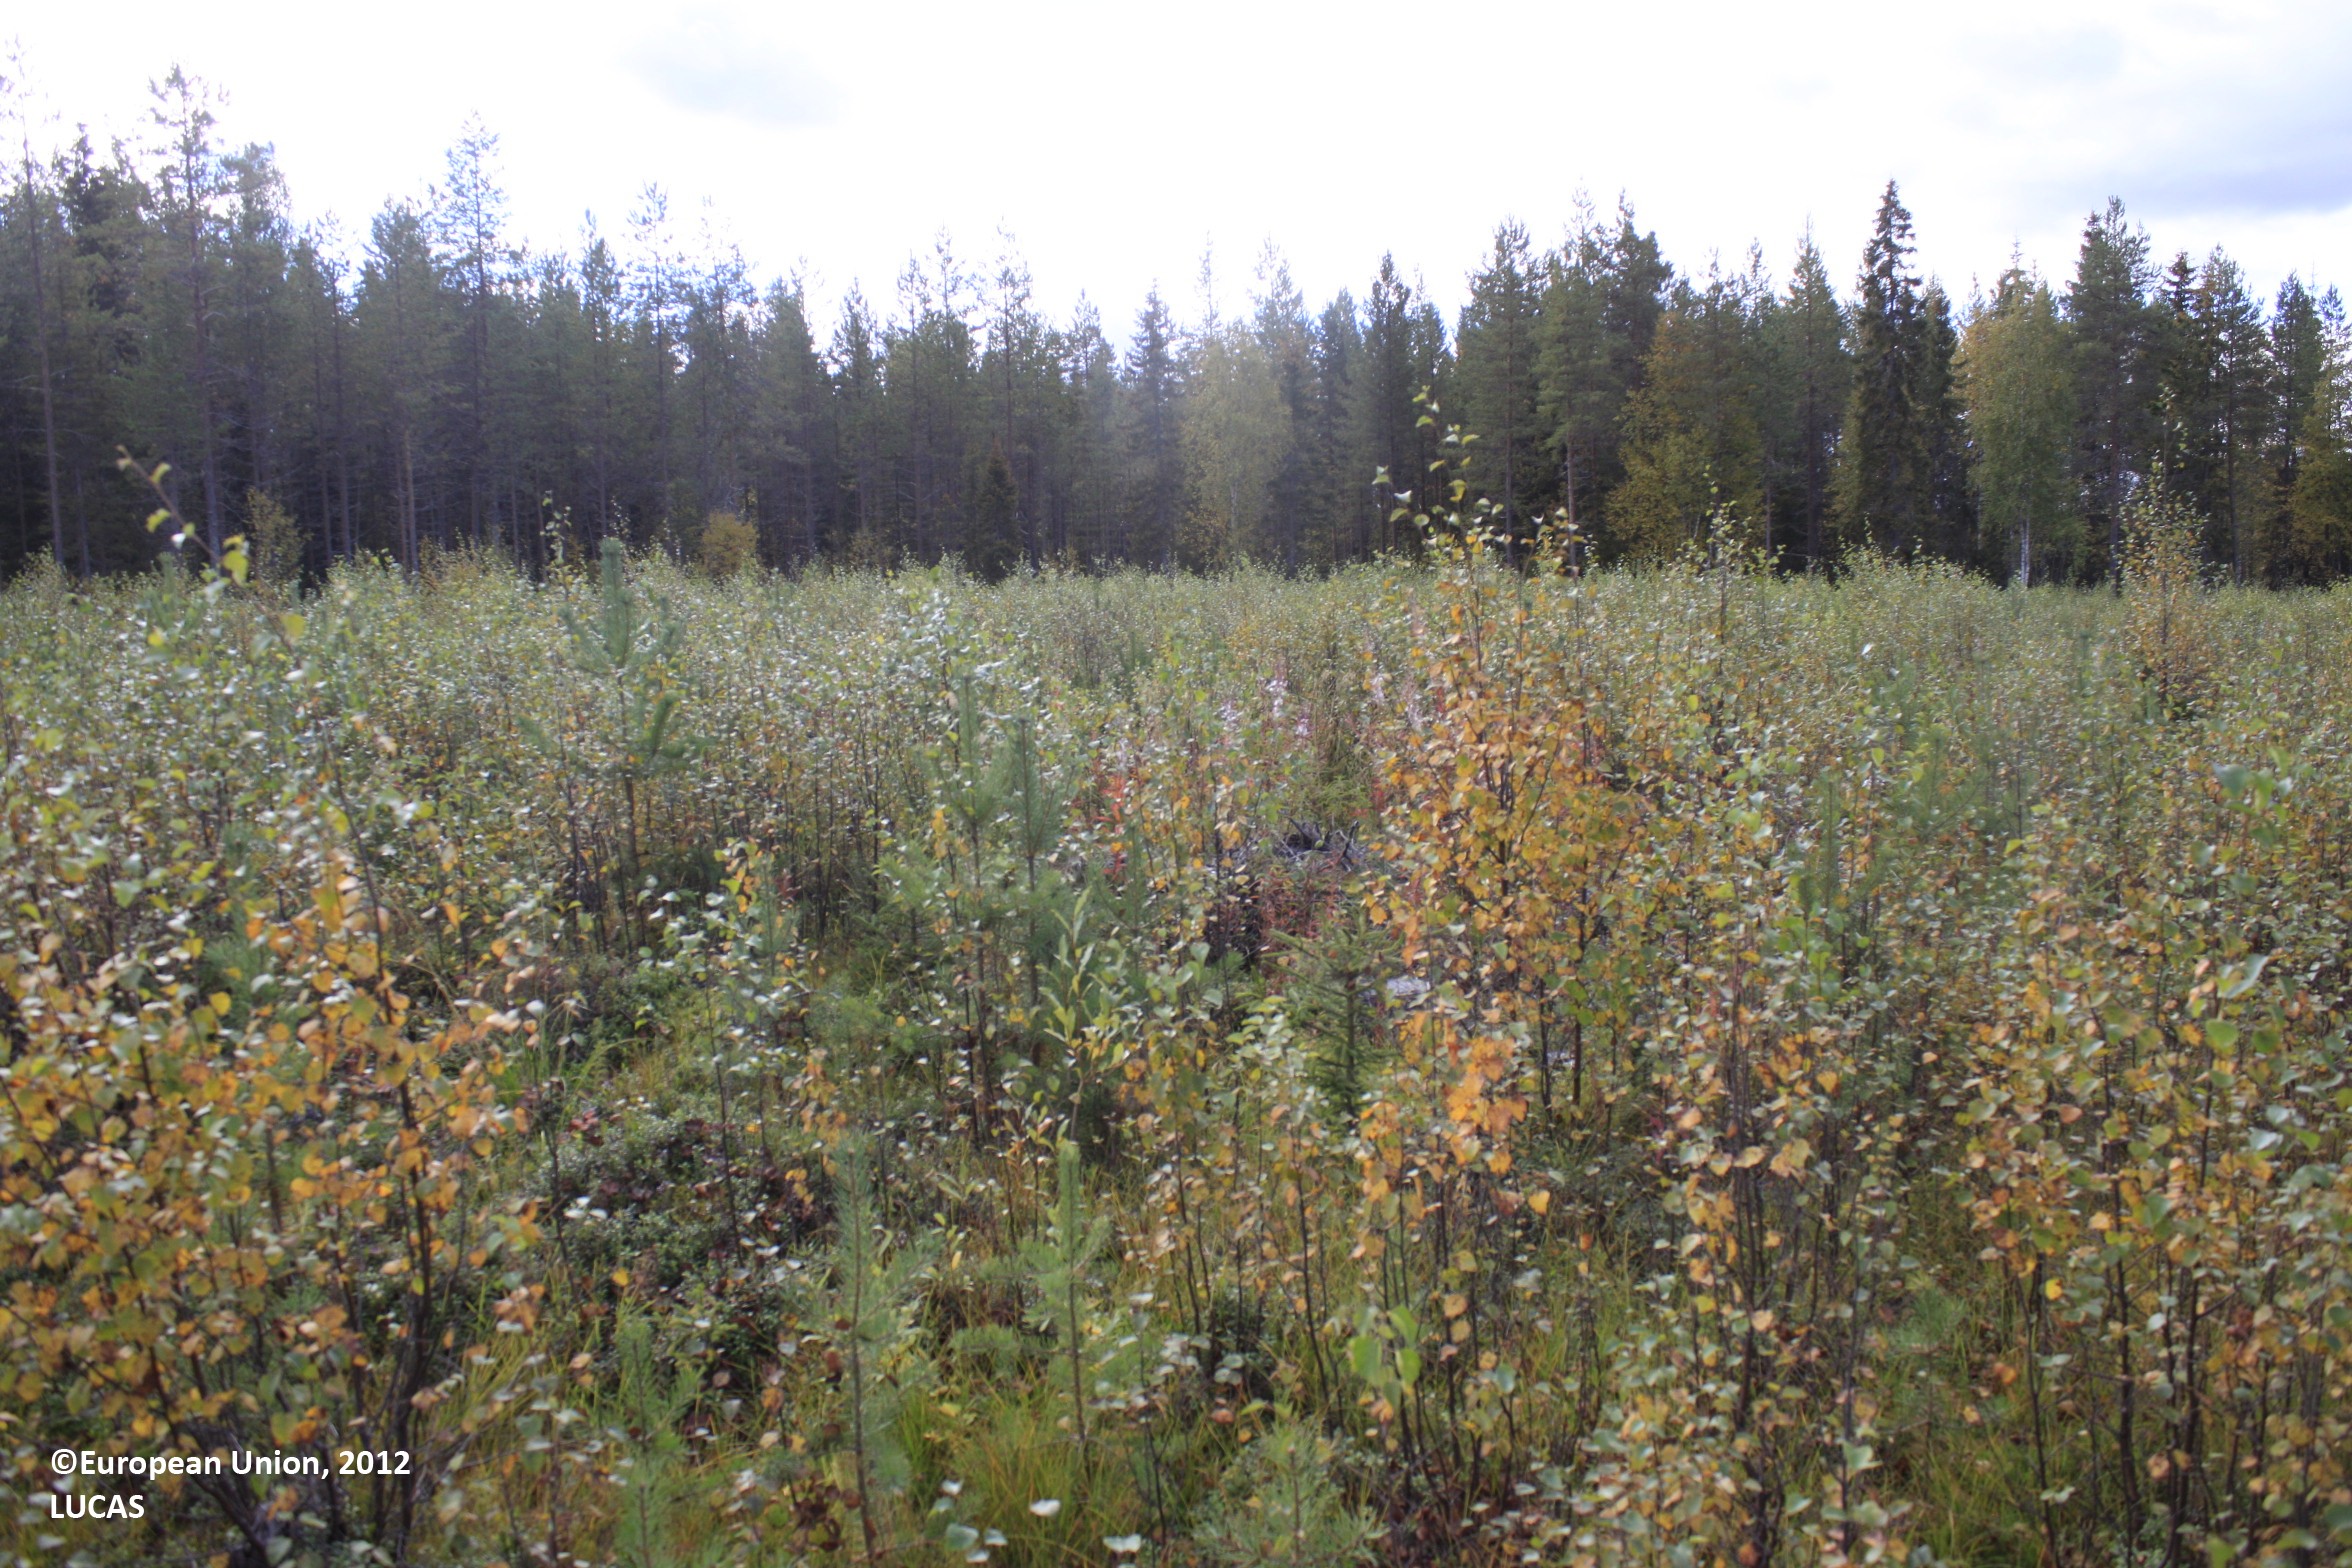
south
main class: Woodland
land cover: Broadleaved woodland
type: boreal forest
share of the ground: 25 - 50 %
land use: Forestry
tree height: < 5 m
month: September
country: FI
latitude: 65.6496
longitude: 26.5992
